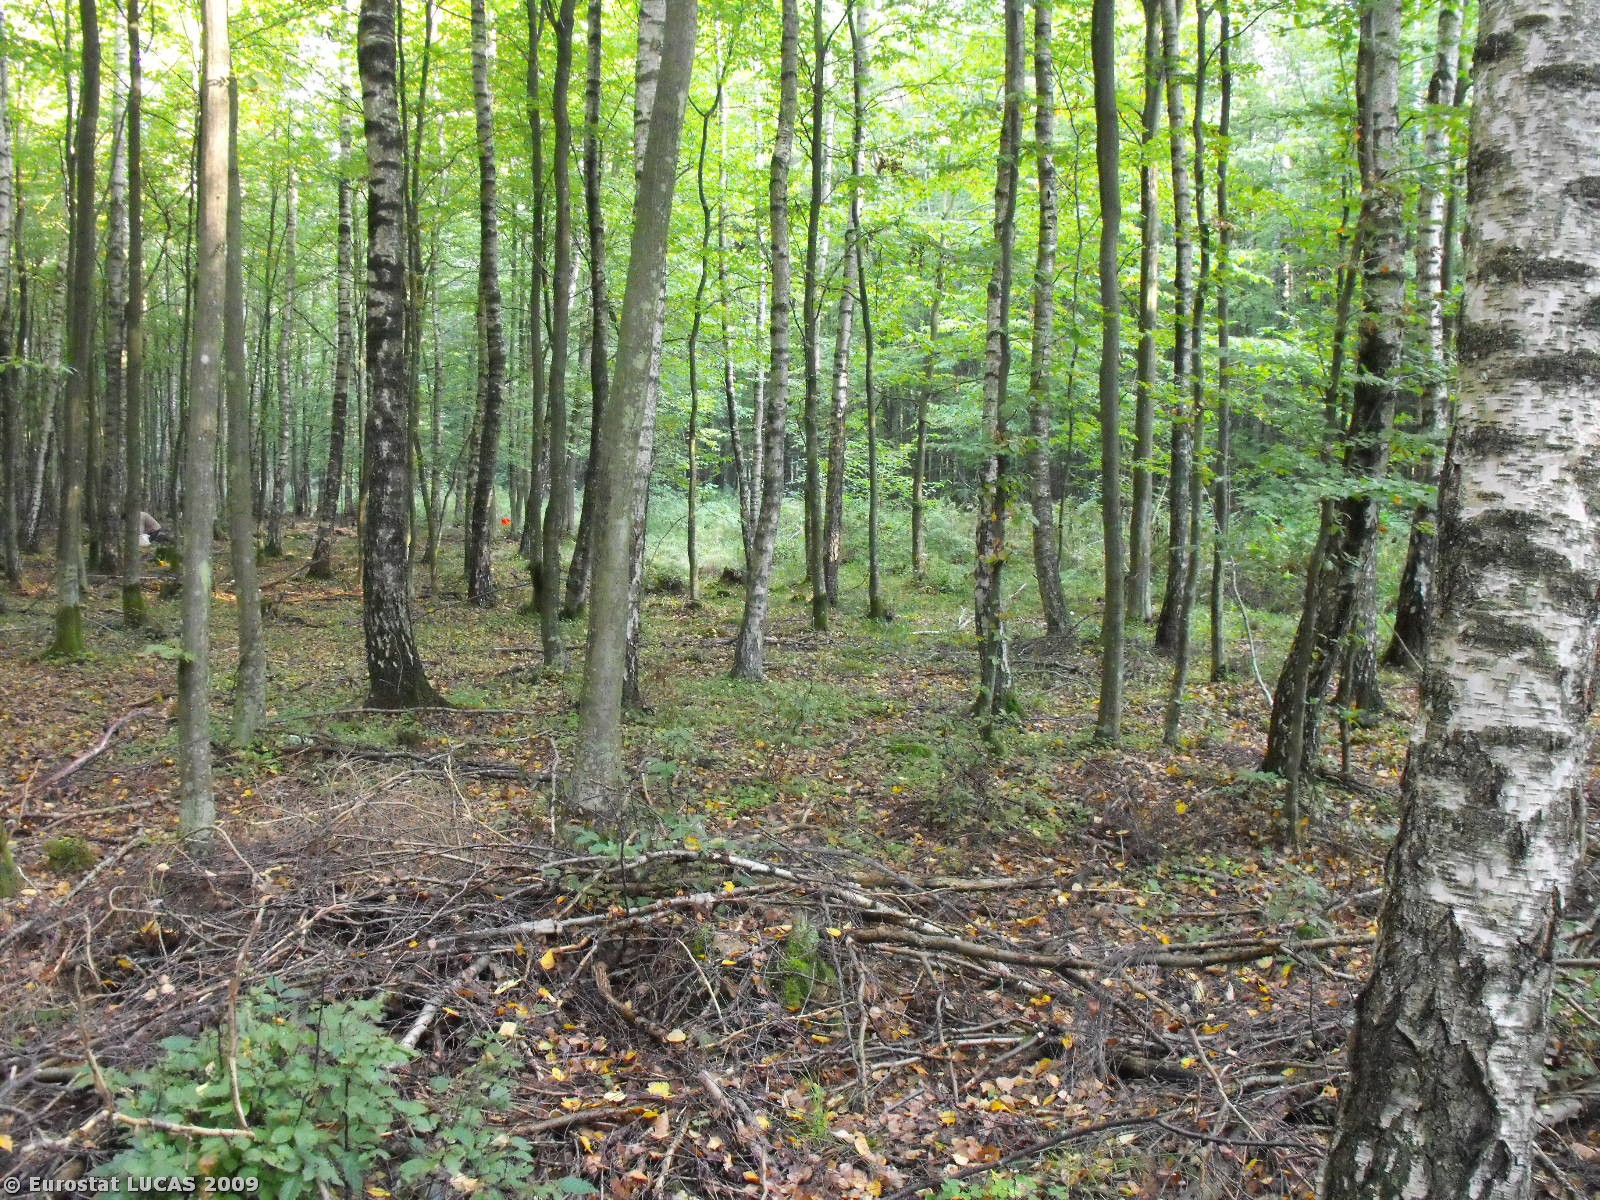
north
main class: Woodland
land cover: Broadleaved woodland
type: hemiboreal forest and nemoral coniferous forest and mixed broadleaved-coniferous forest
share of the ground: > 75 %
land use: Forestry
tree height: > 5 m
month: September
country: PL
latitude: 54.3920
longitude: 16.6441
